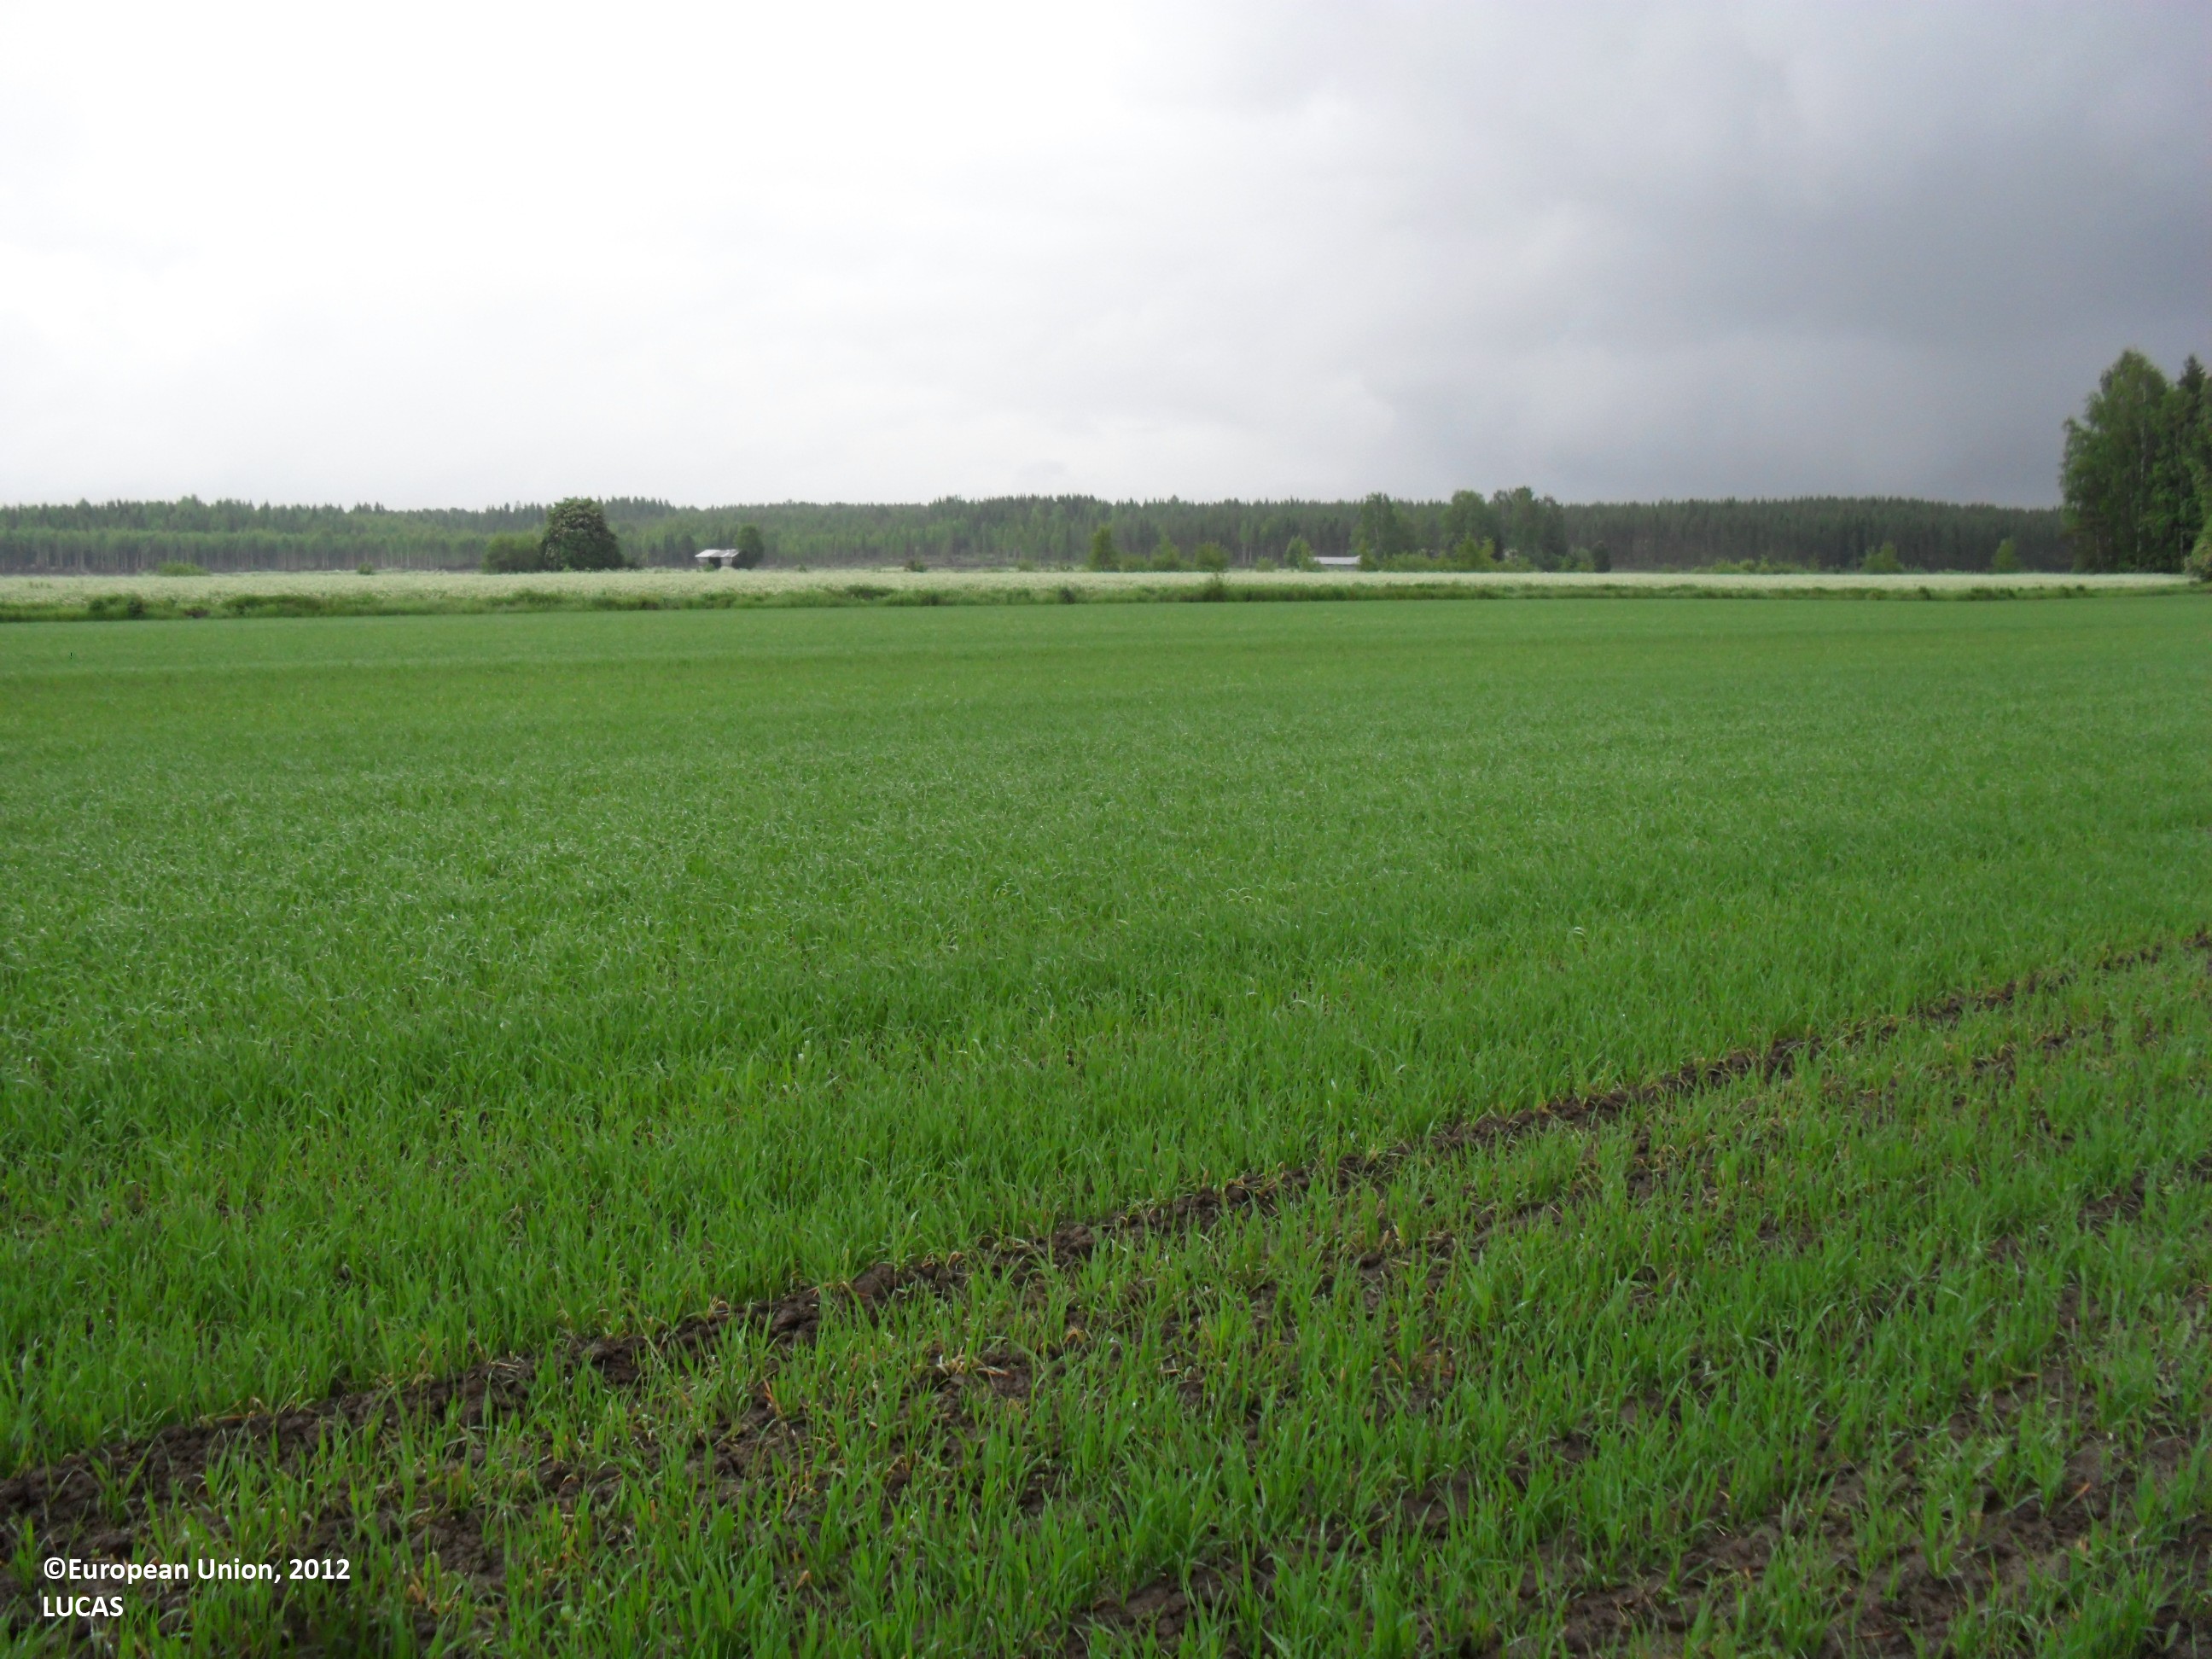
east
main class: Cropland
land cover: Barley
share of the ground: 25 - 50 %
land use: Agriculture (excluding fallow land and kitchen gardens)
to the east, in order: Barley; Ditches and canals; Other non-permanent industrial crops; Grass margins; Rivers and streams; Abandoned hedges; Grass margins; Barley; Ditches and canals; Grass margins; Paved roads, cycling and walking lanes; Single bushes/trees; Grassland without tree/shrub cover
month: June
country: FI
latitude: 63.0988
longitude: 23.1148
